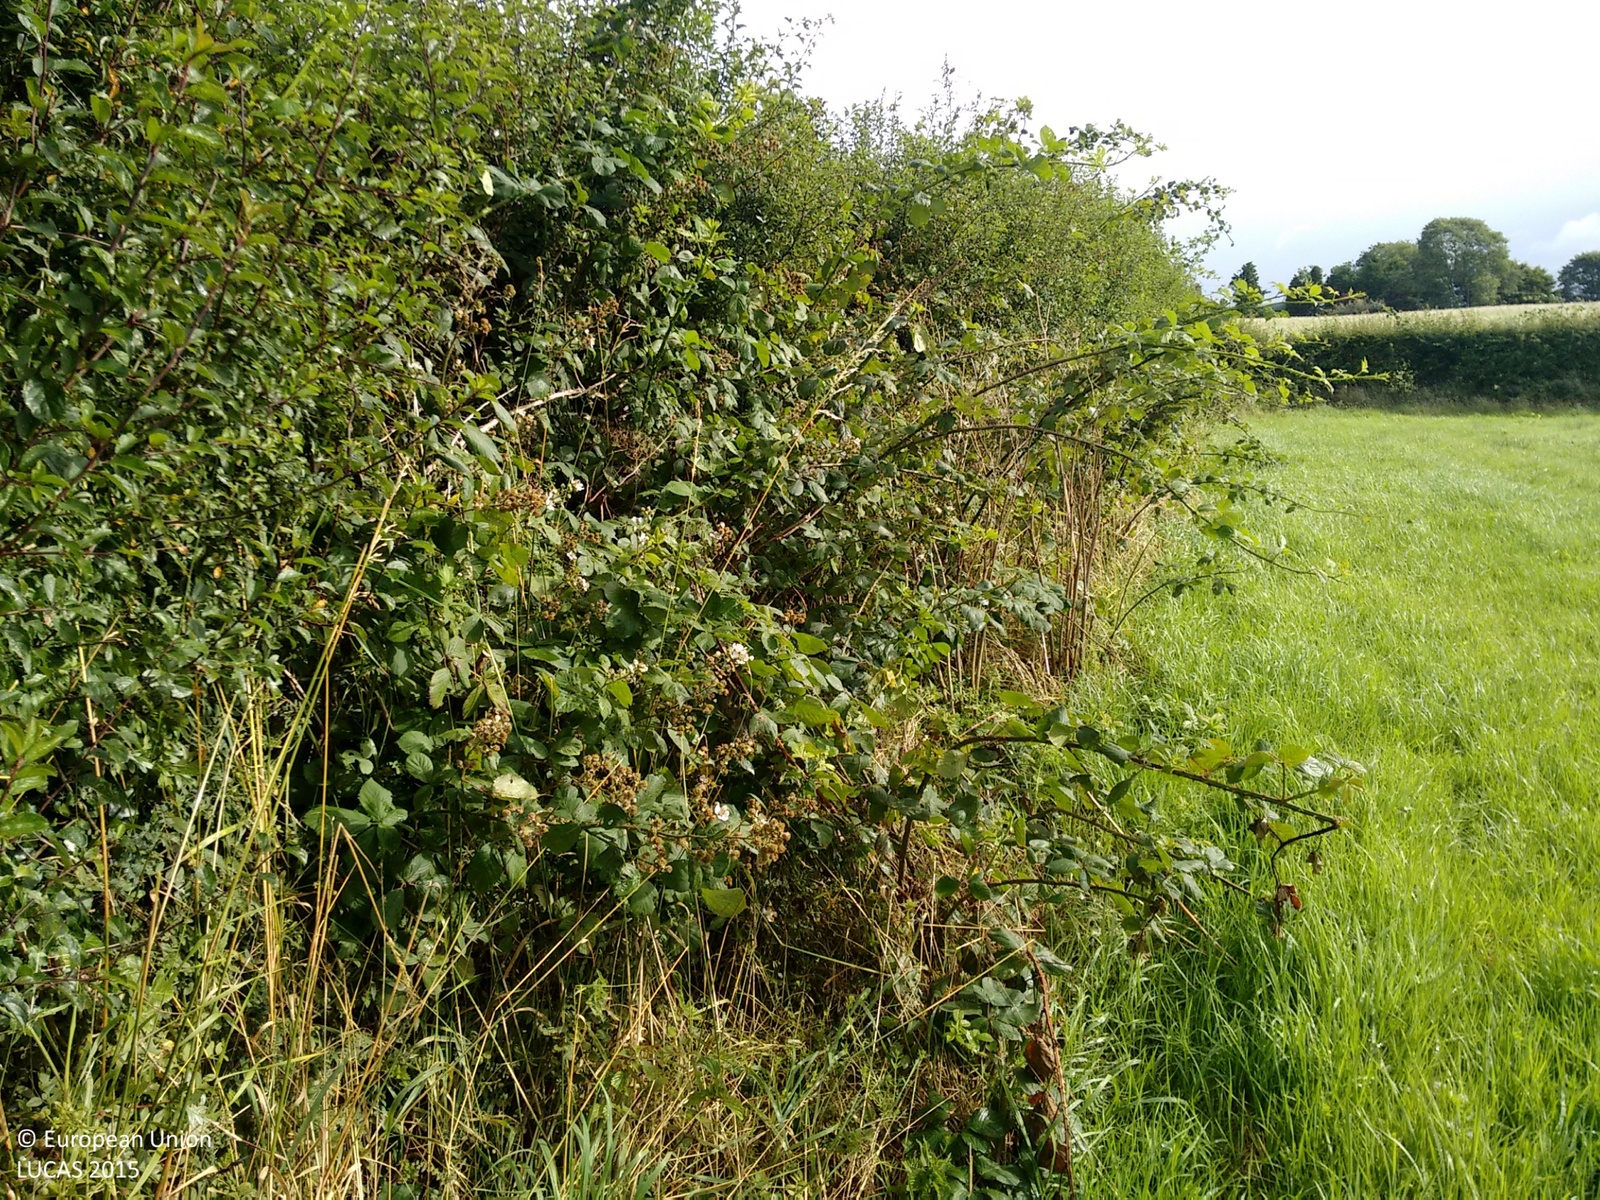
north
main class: Grassland
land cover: Grassland without tree/shrub cover
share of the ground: > 75 %
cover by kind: herbaceous plants 100 %
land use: Agriculture (excluding fallow land and kitchen gardens)
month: August
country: GB
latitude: 54.4715
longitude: -5.8926
